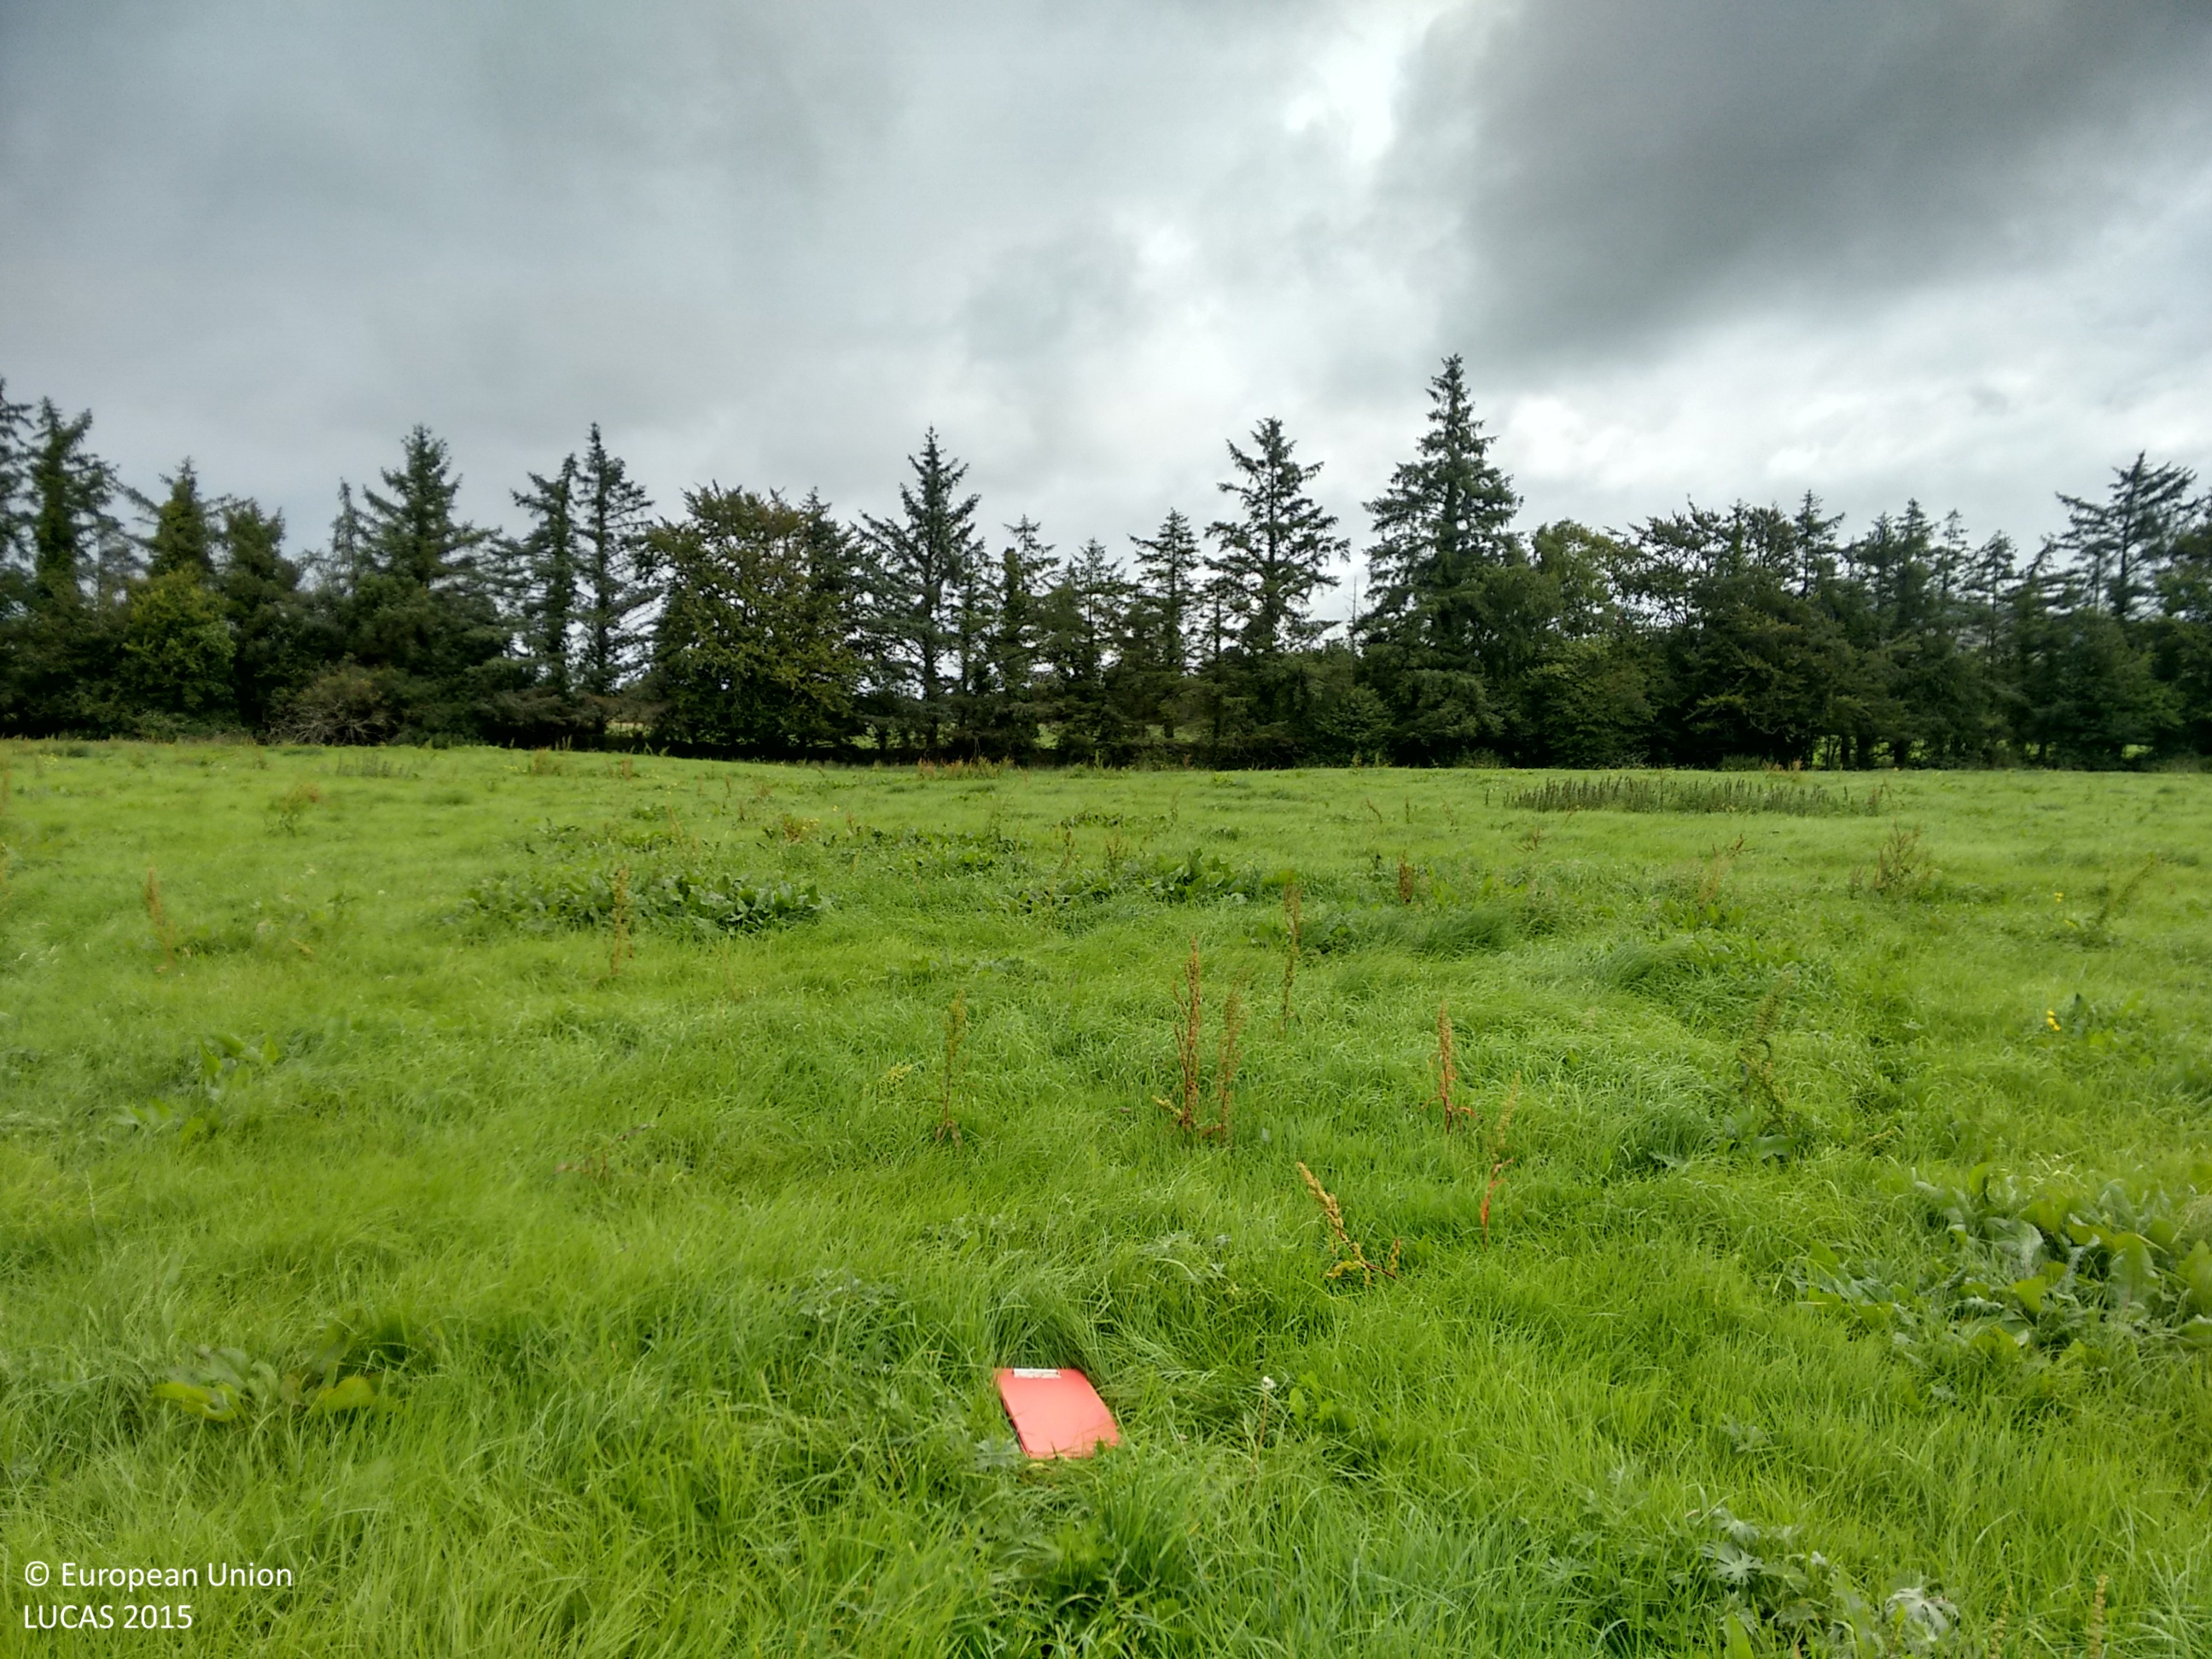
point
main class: Grassland
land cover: Grassland without tree/shrub cover
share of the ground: > 75 %
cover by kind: herbaceous plants 100 %
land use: Agriculture (excluding fallow land and kitchen gardens)
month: September
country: IE
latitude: 52.3847
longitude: -8.4854
